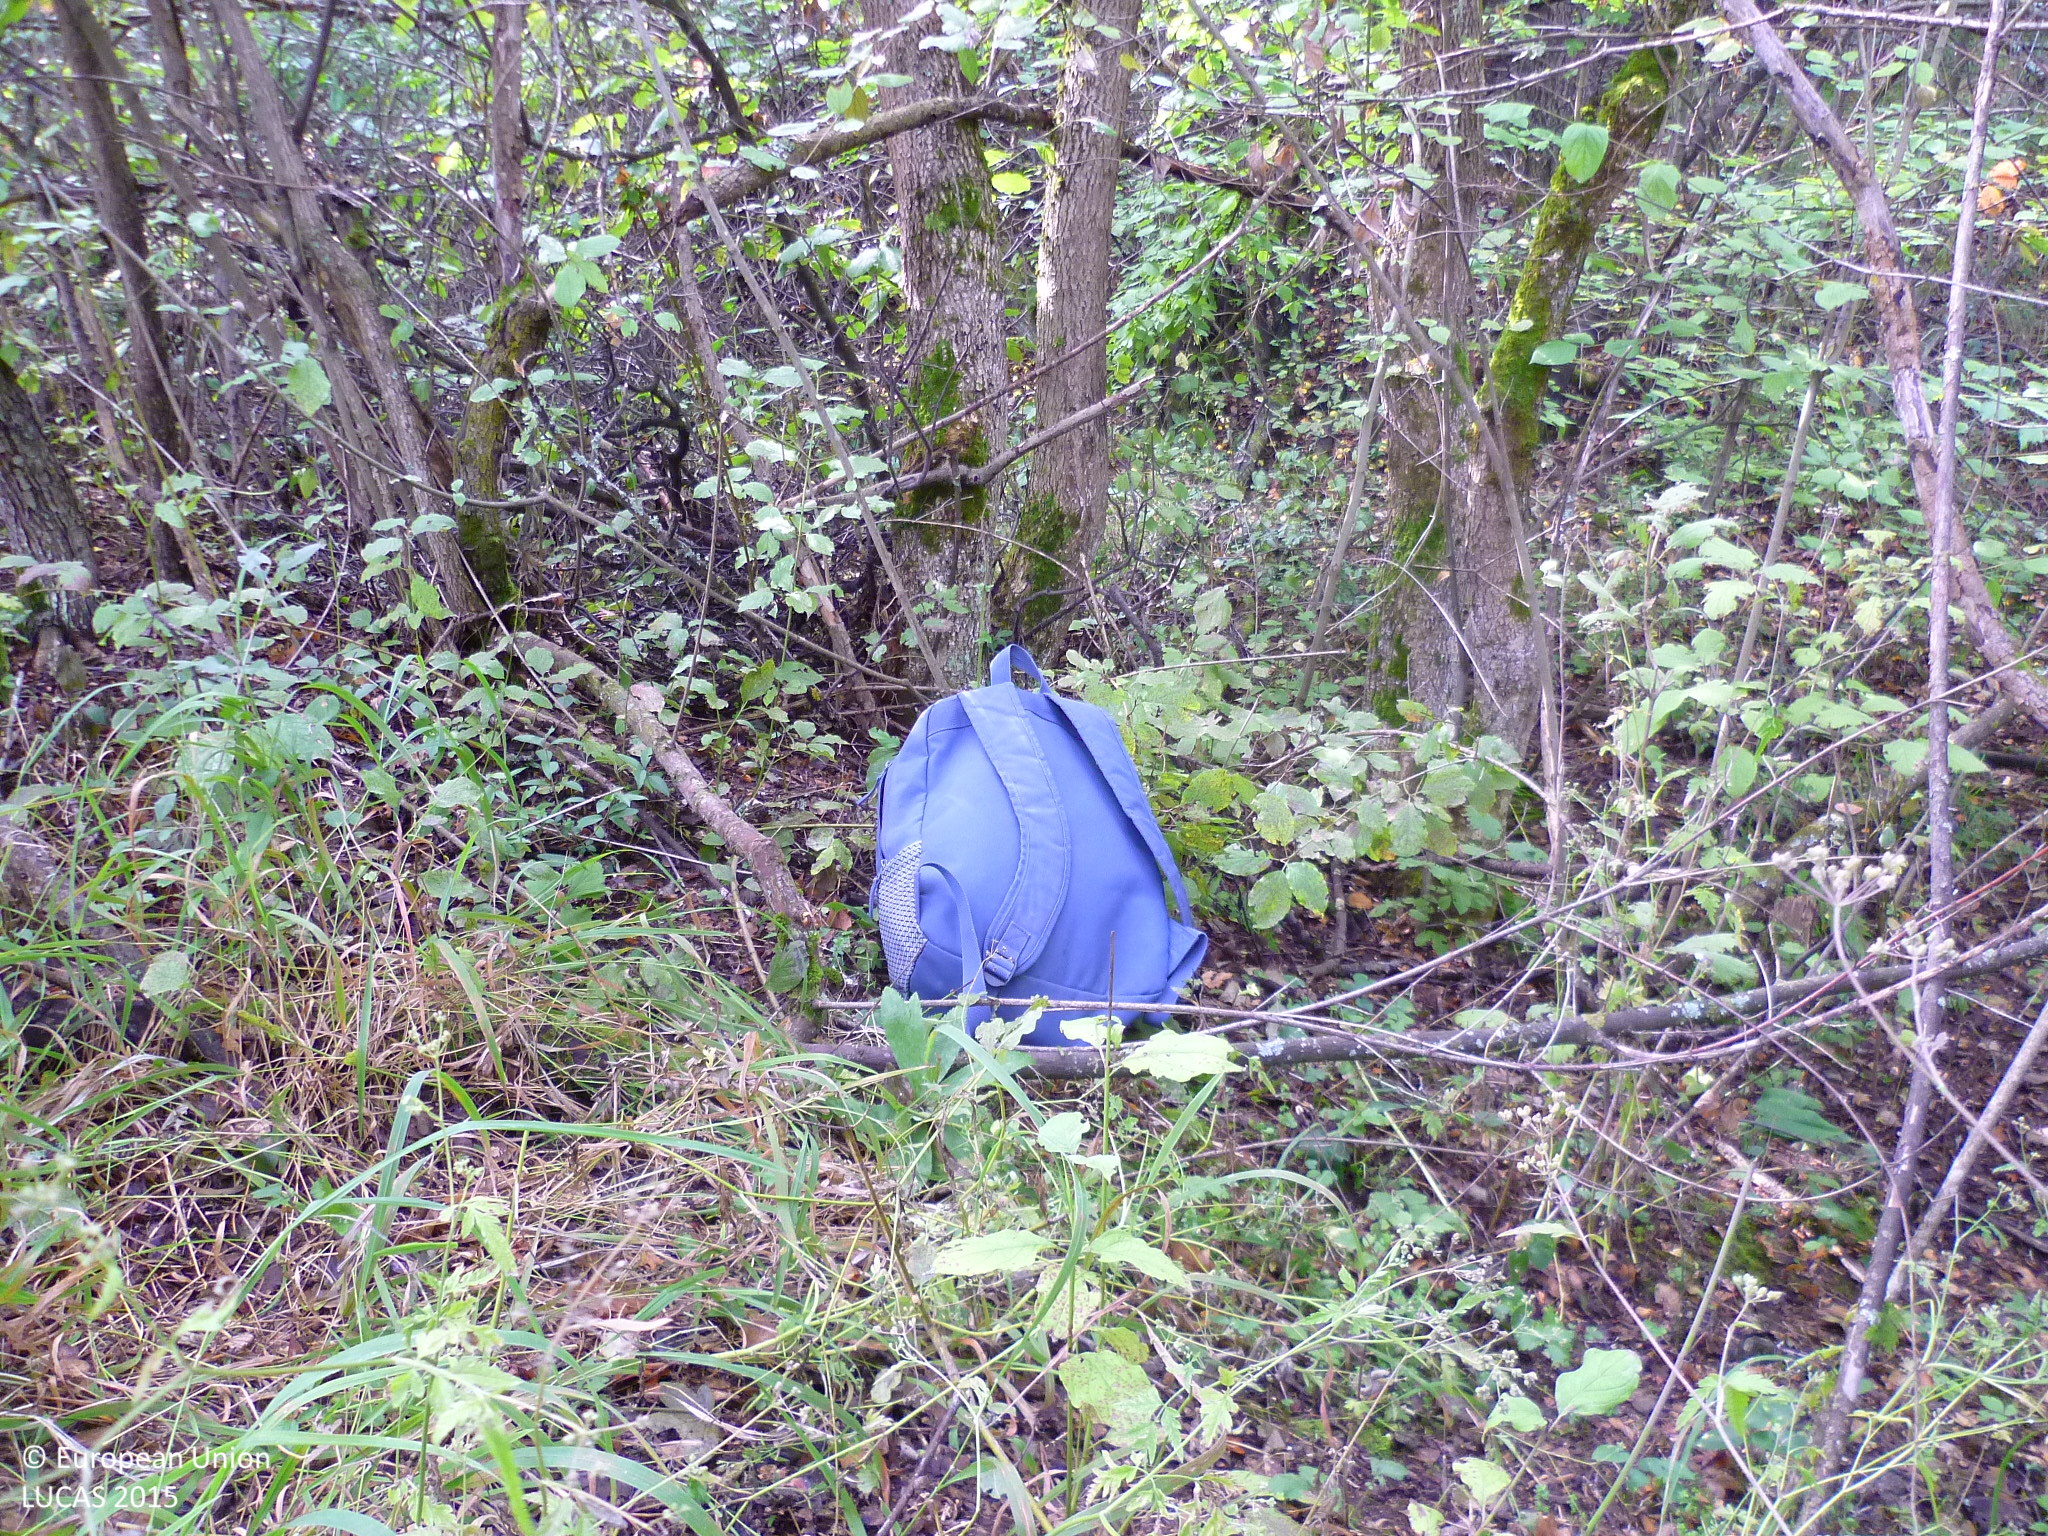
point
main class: Woodland
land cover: Broadleaved woodland
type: mesophytic deciduous forest
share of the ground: > 75 %
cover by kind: broadleaved forest trees 80 %, herbaceous plants 20 %
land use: Semi-natural and natural areas not in use
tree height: > 5 m
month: September
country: BG
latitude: 42.8283
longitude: 22.9109
